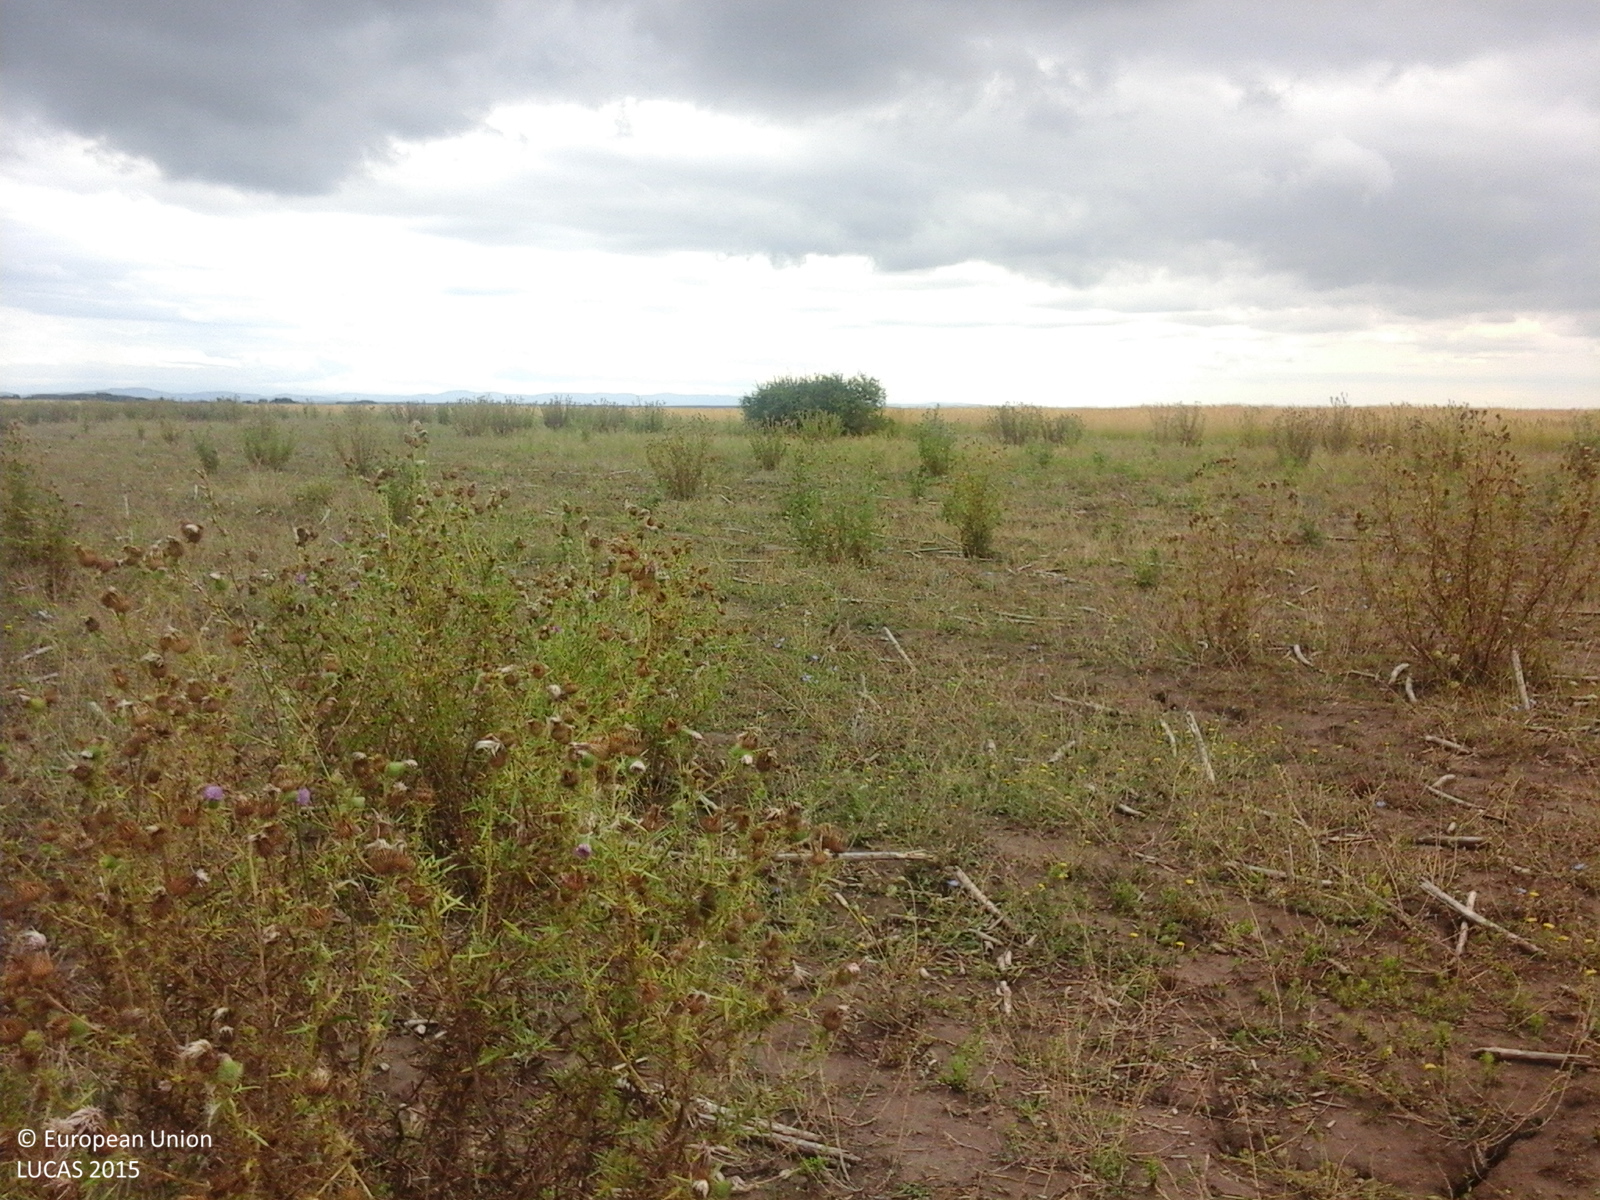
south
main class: Grassland
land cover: Spontaneously vegetated surfaces
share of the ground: > 75 %
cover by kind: herbaceous plants 100 %
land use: Agriculture (excluding fallow land and kitchen gardens)
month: August
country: RO
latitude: 45.5623
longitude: 21.5251
